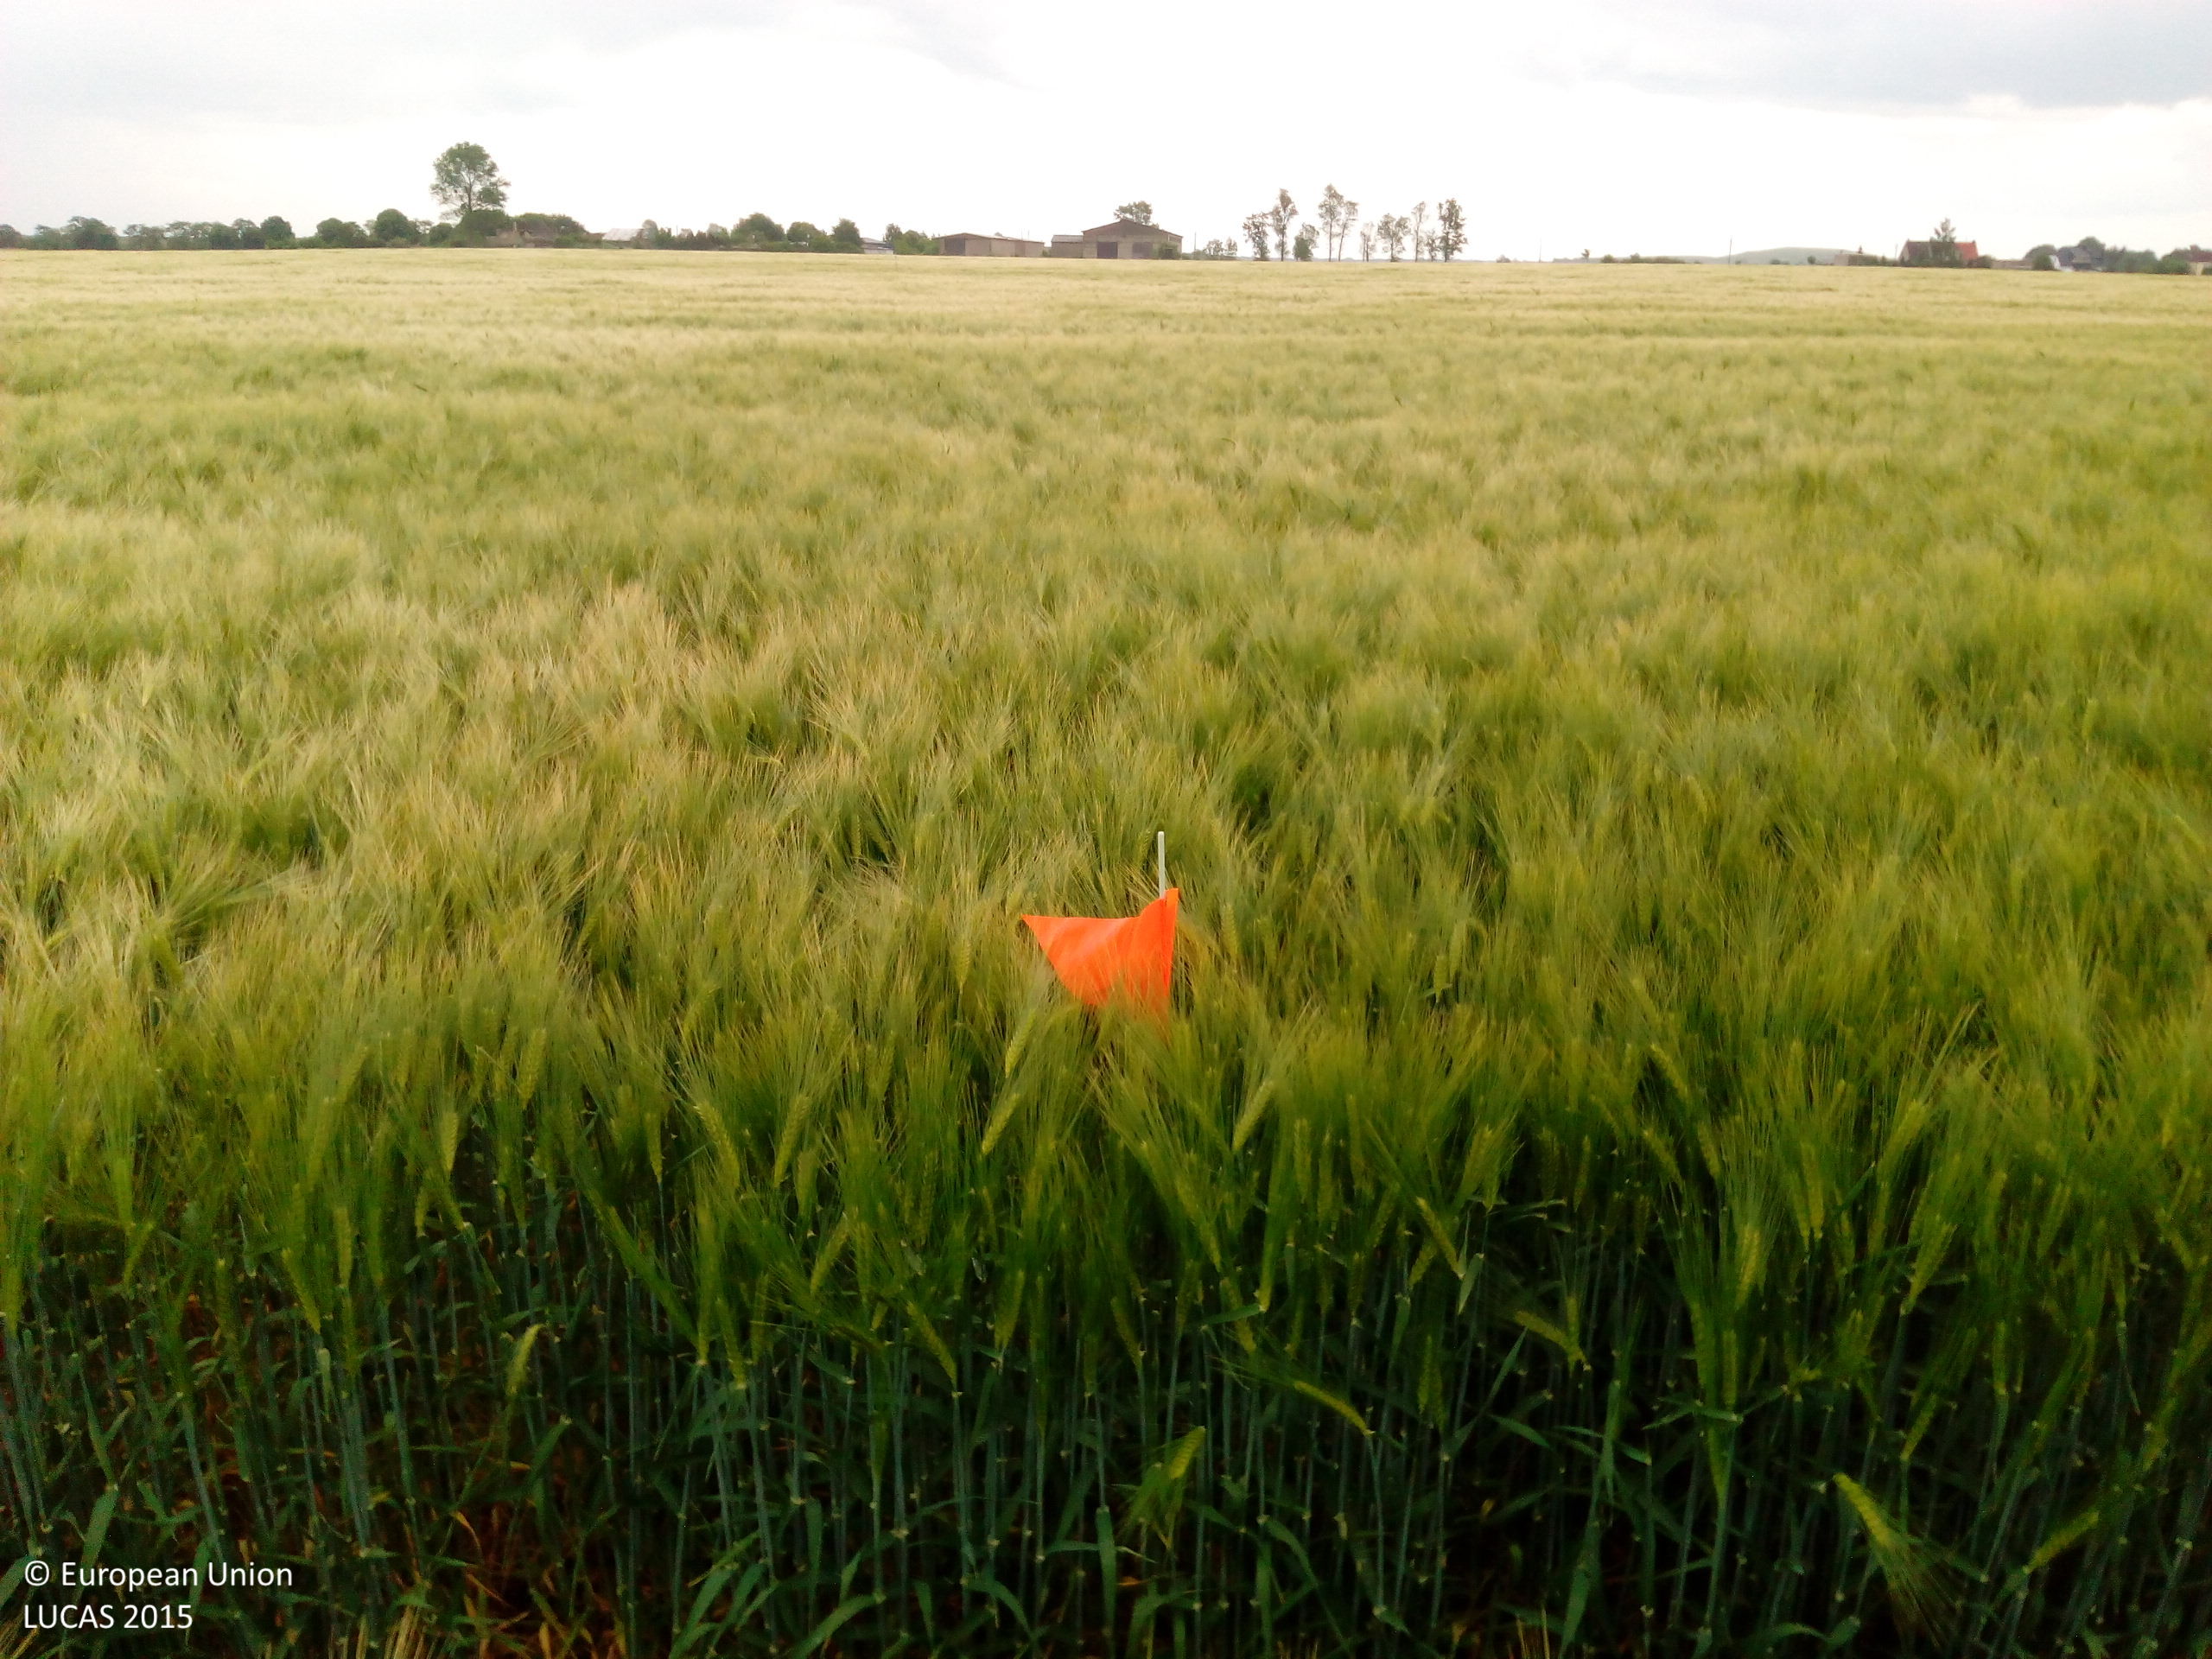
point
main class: Cropland
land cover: Barley
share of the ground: > 75 %
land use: Agriculture (excluding fallow land and kitchen gardens)
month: May
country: DE
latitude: 51.5624
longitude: 12.3799
